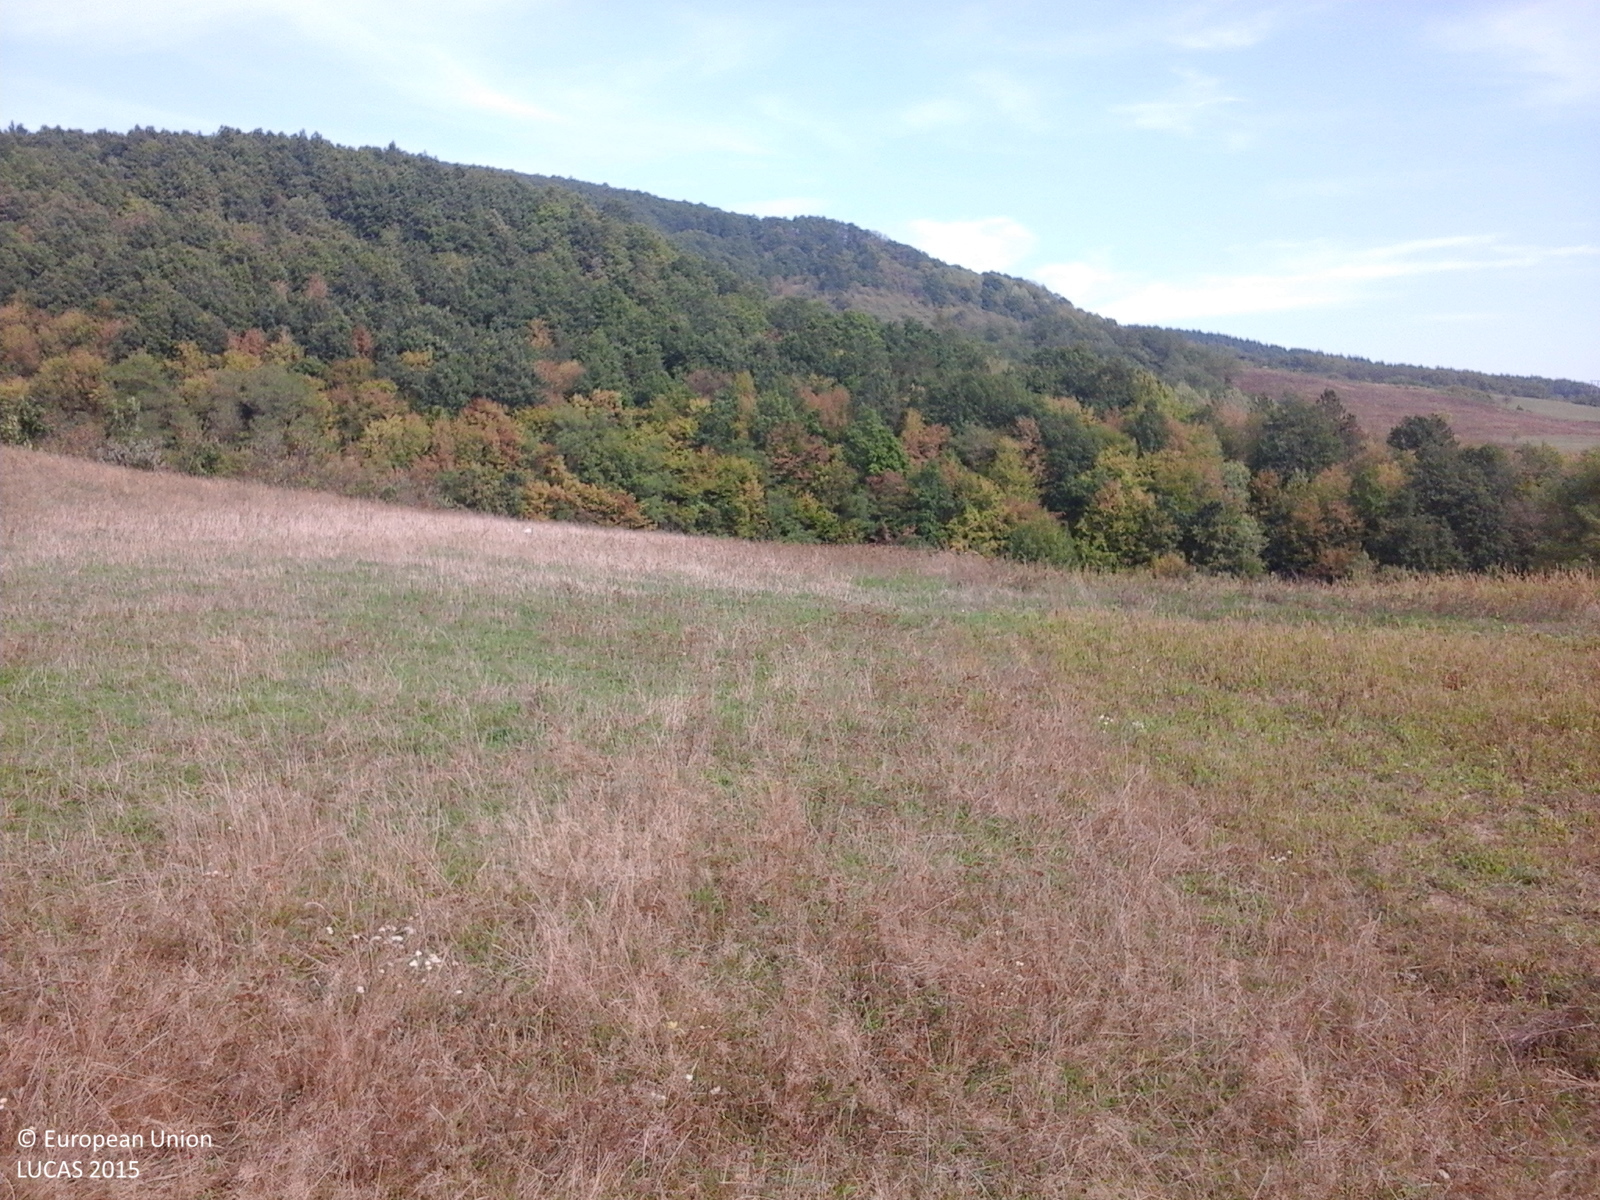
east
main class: Grassland
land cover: Grassland without tree/shrub cover
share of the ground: > 75 %
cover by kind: herbaceous plants 100 %
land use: Agriculture (excluding fallow land and kitchen gardens)
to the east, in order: Grassland without tree/shrub cover; Tracks; Spontaneously vegetated surfaces; Grassland without tree/shrub cover; Grassland with sparse tree/shrub cover; Tracks; Rocks and stones; Ditches and canals; Abandoned hedges; Grassland without tree/shrub cover; Abandoned hedges; Broadleaved woodland; Tracks; Lines of trees; Other fruit trees and berries; Grassland without tree/shrub cover; Other fruit trees and berries
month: September
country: RO
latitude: 47.2261
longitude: 23.7727
